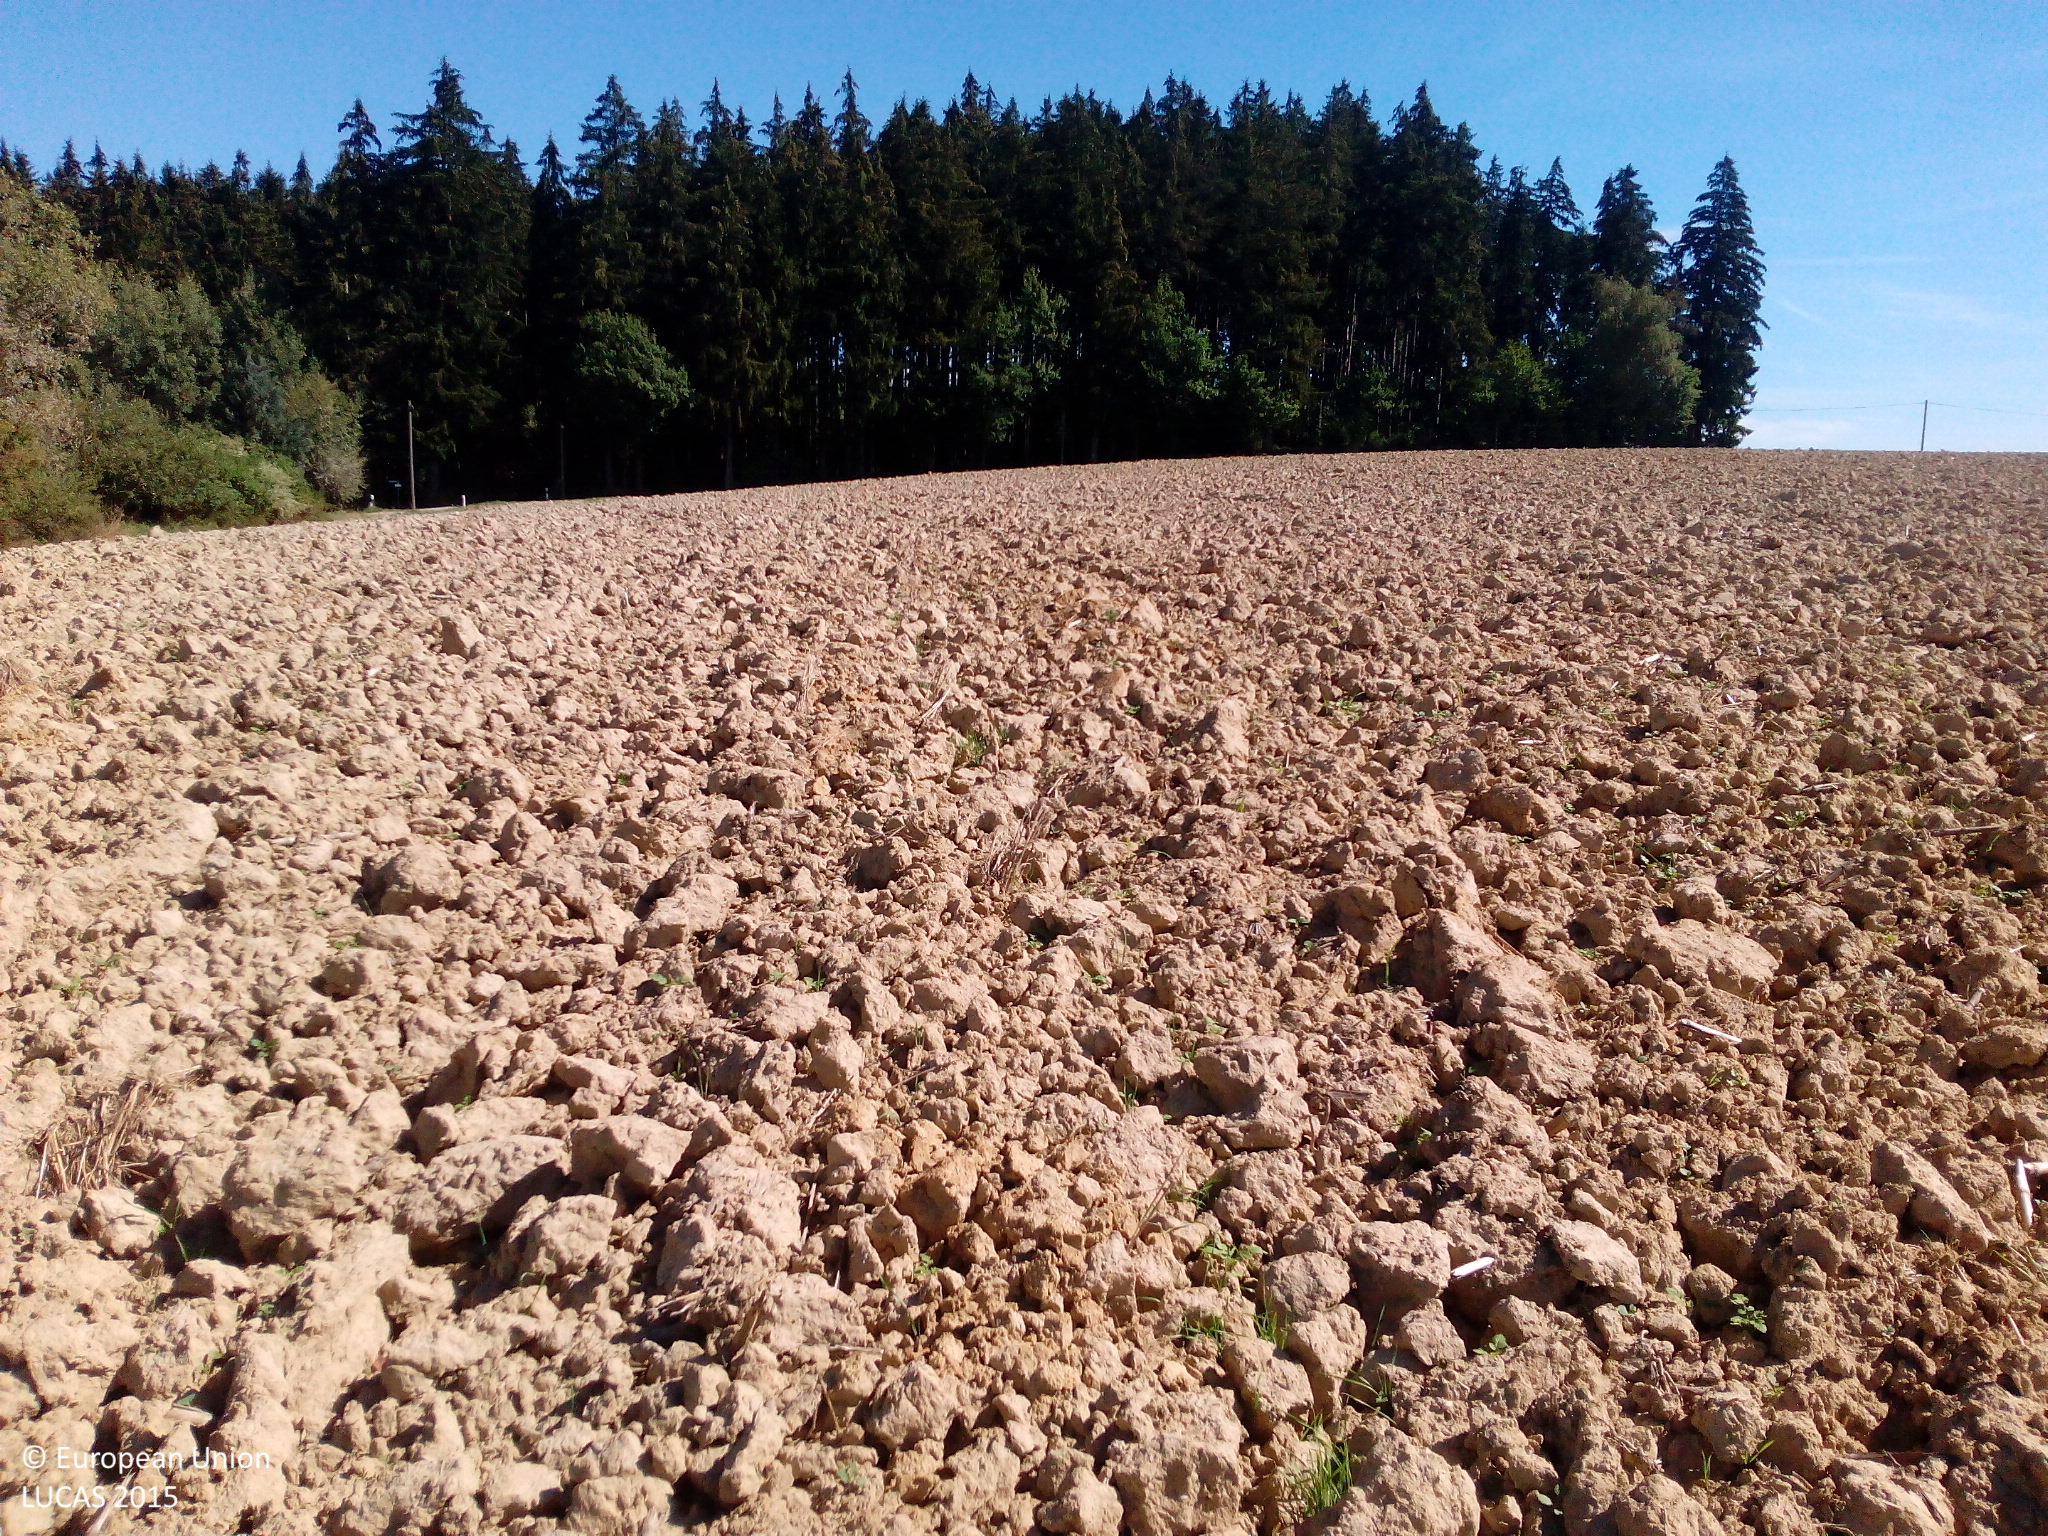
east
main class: Cropland
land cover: Rape and turnip rape
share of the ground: < 10 %
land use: Agriculture (excluding fallow land and kitchen gardens)
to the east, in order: Rape and turnip rape; Grass margins; Paved roads, cycling and walking lanes; Electric lines; Spruce dominated coniferous woodland; Tracks; Spruce dominated coniferous woodland
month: September
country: DE
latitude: 48.4202
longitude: 12.0665
